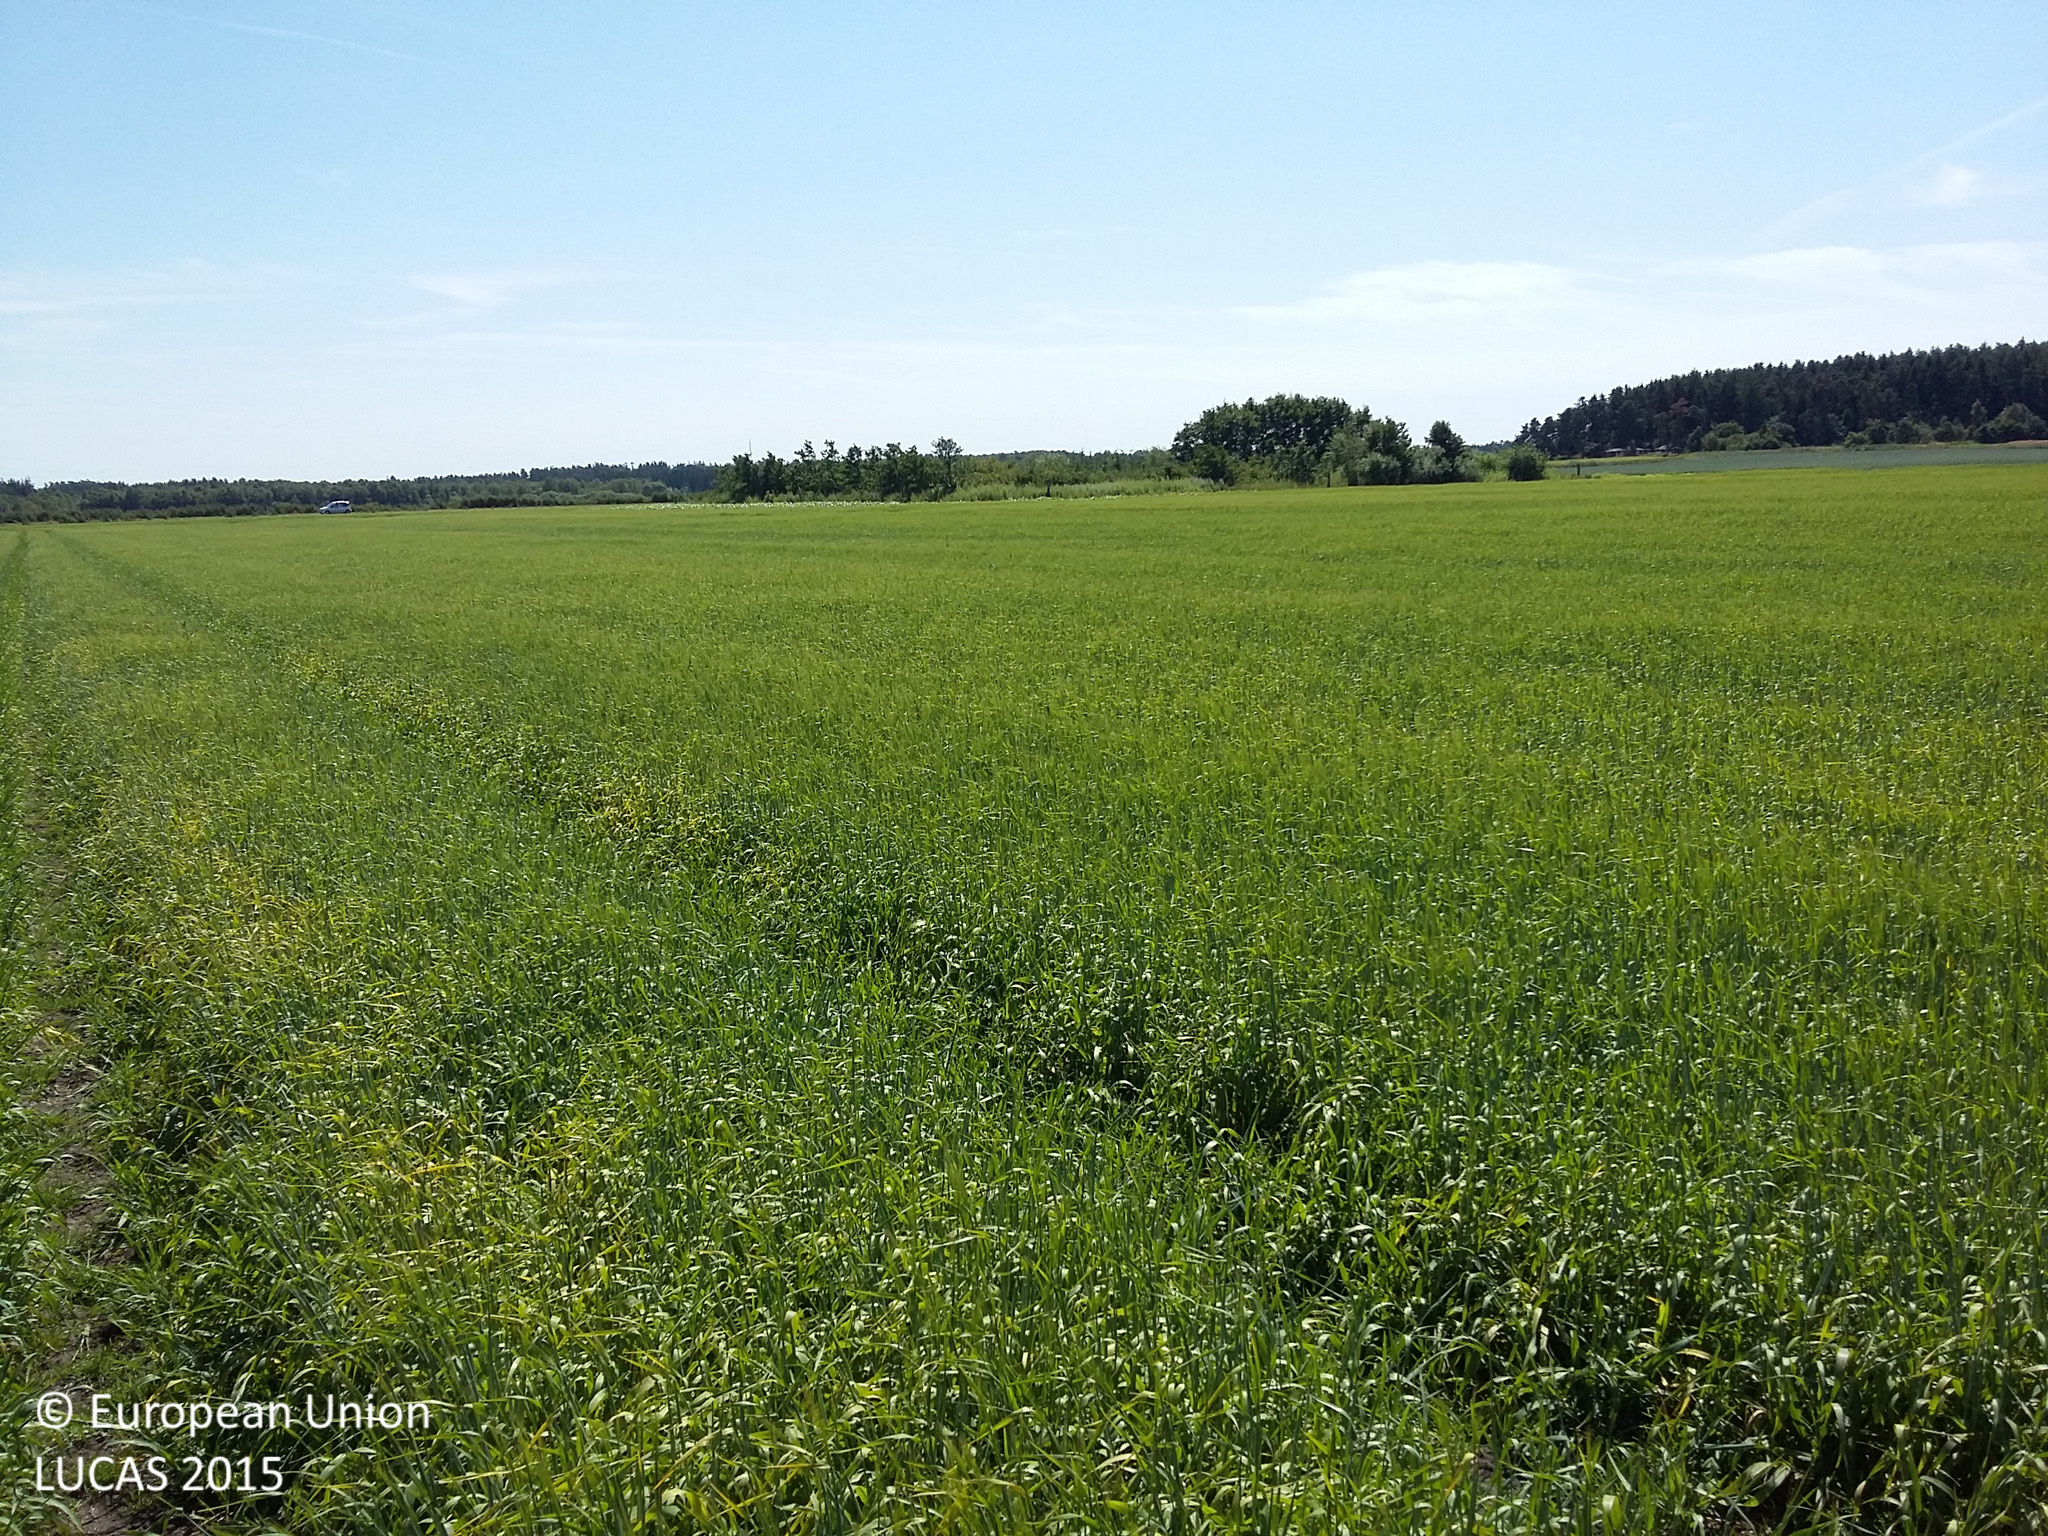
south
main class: Cropland
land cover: Barley
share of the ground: > 75 %
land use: Agriculture (excluding fallow land and kitchen gardens)
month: July
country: DK
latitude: 55.5853
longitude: 11.5375
